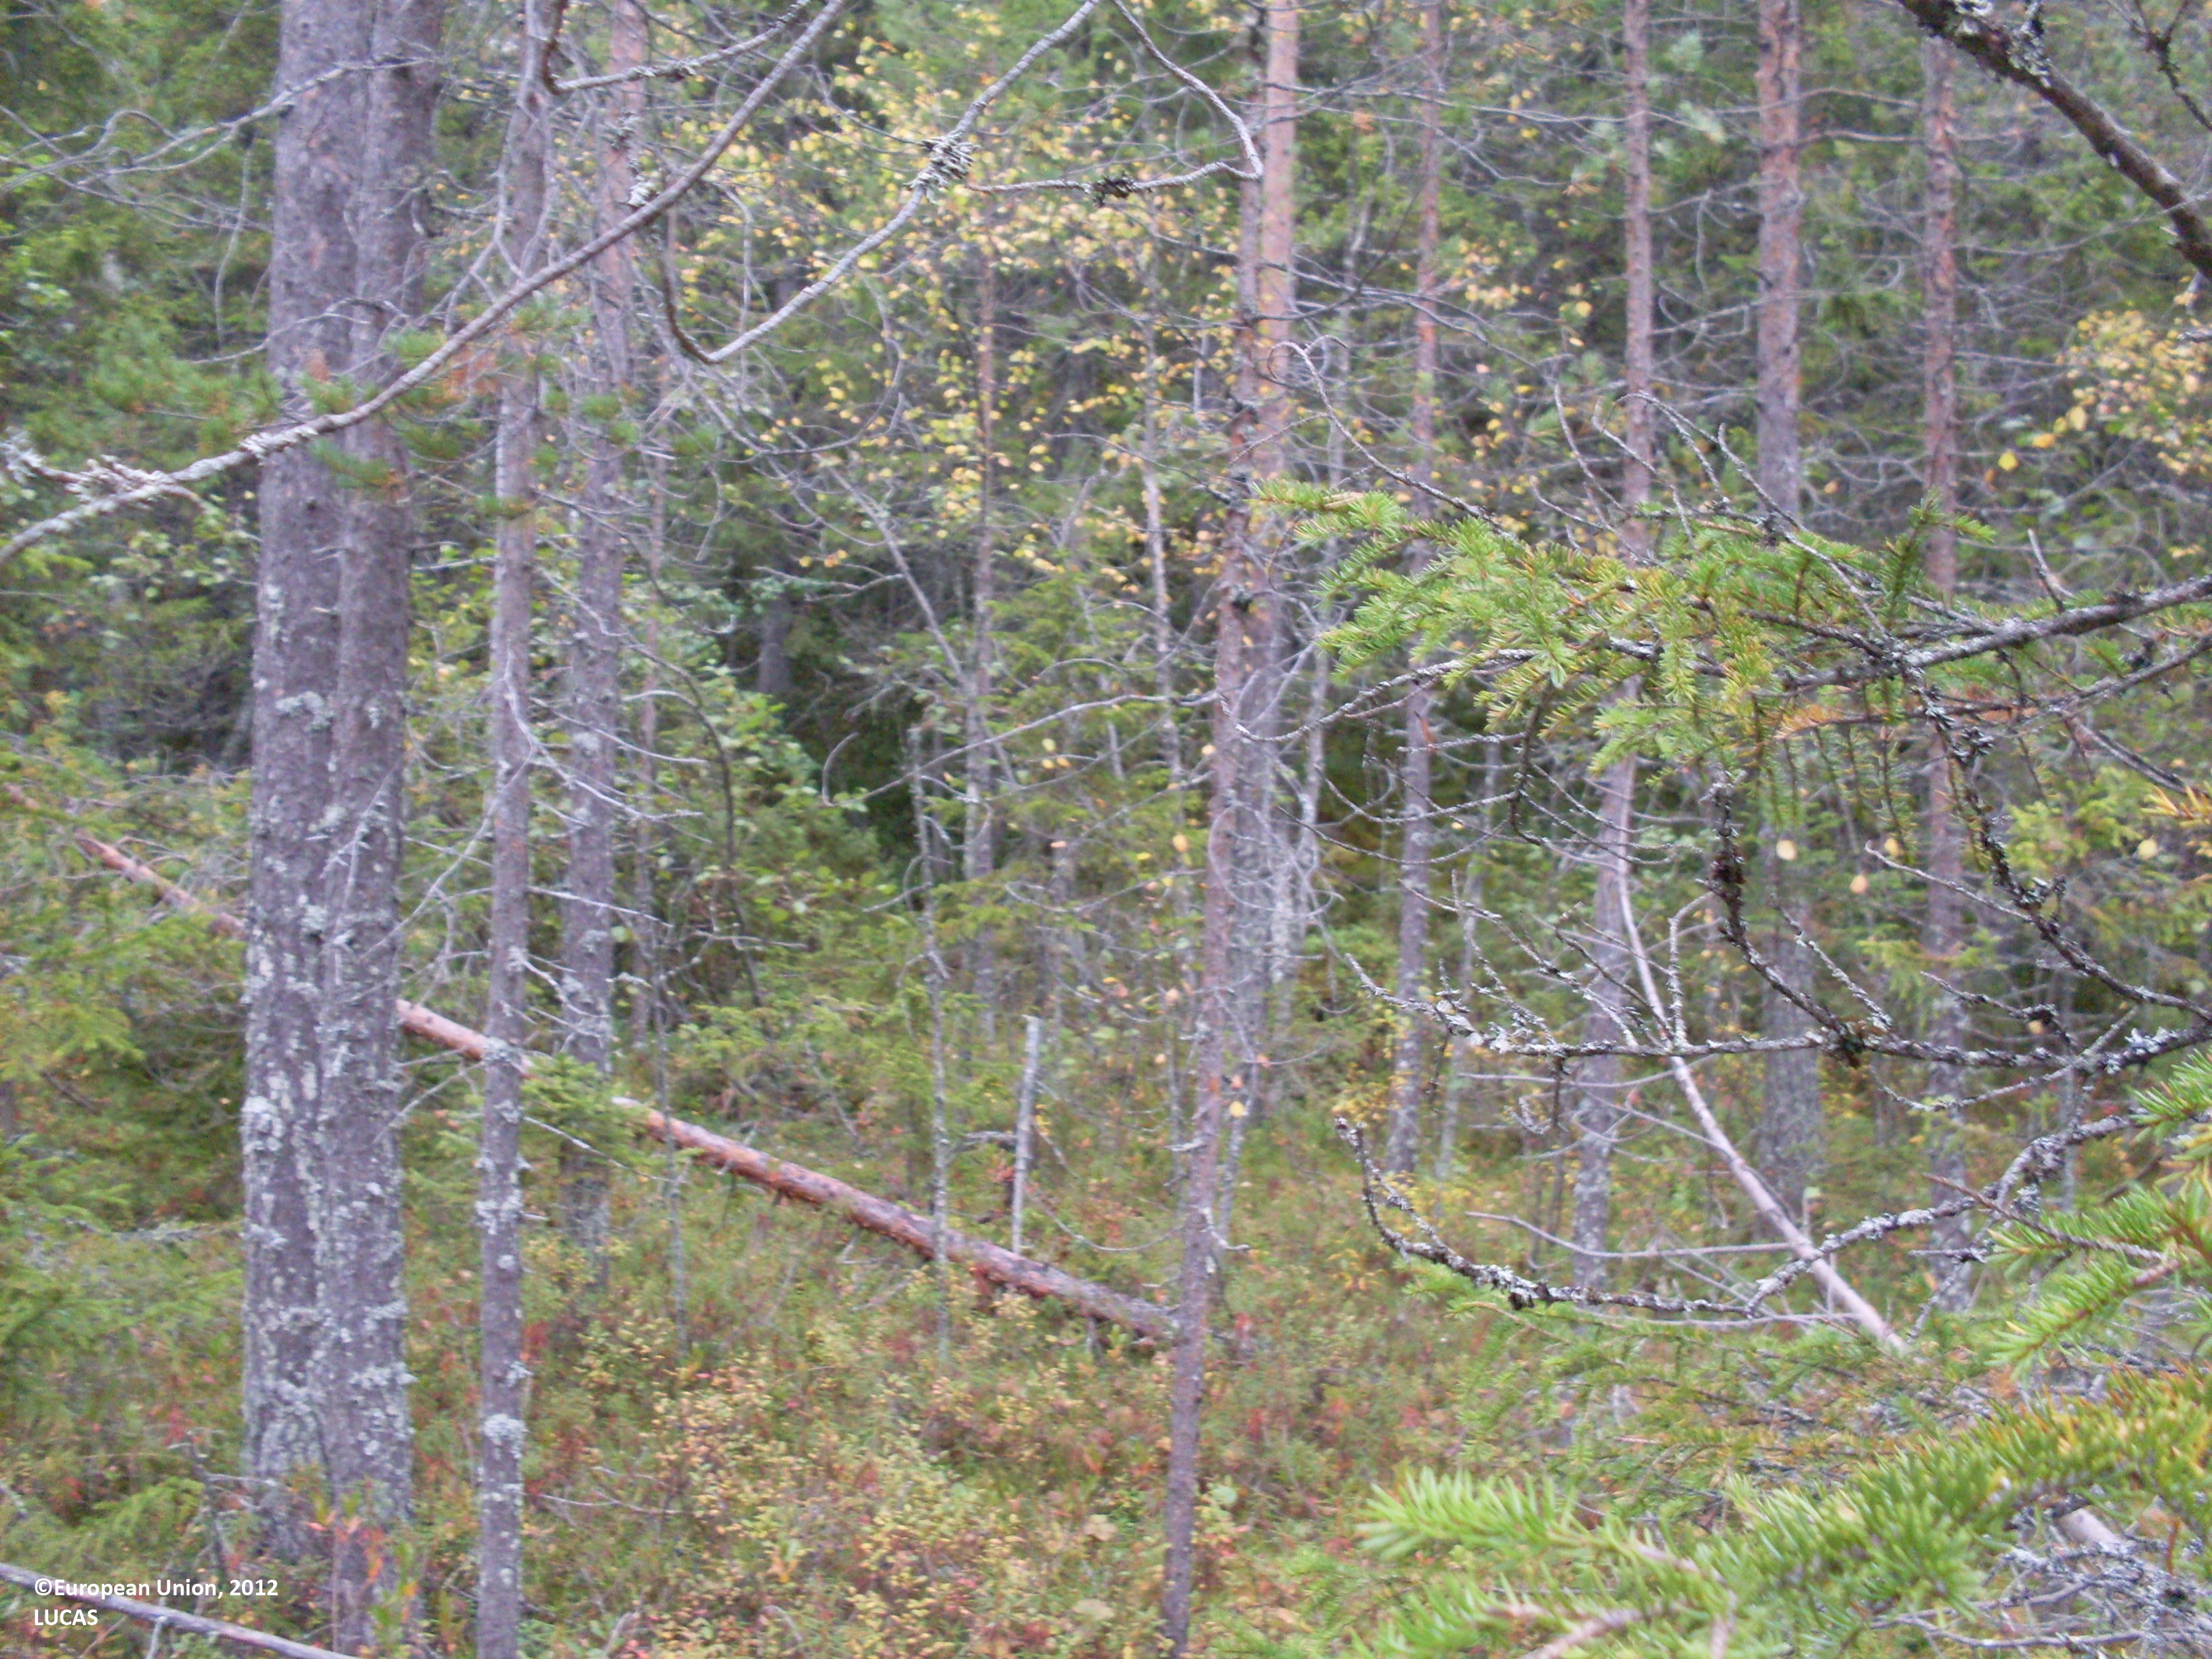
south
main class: Woodland
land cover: Pine dominated coniferous woodland
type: boreal forest
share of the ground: 50 - 75 %
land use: Forestry
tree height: > 5 m
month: September
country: FI
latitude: 64.2021
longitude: 29.4725
